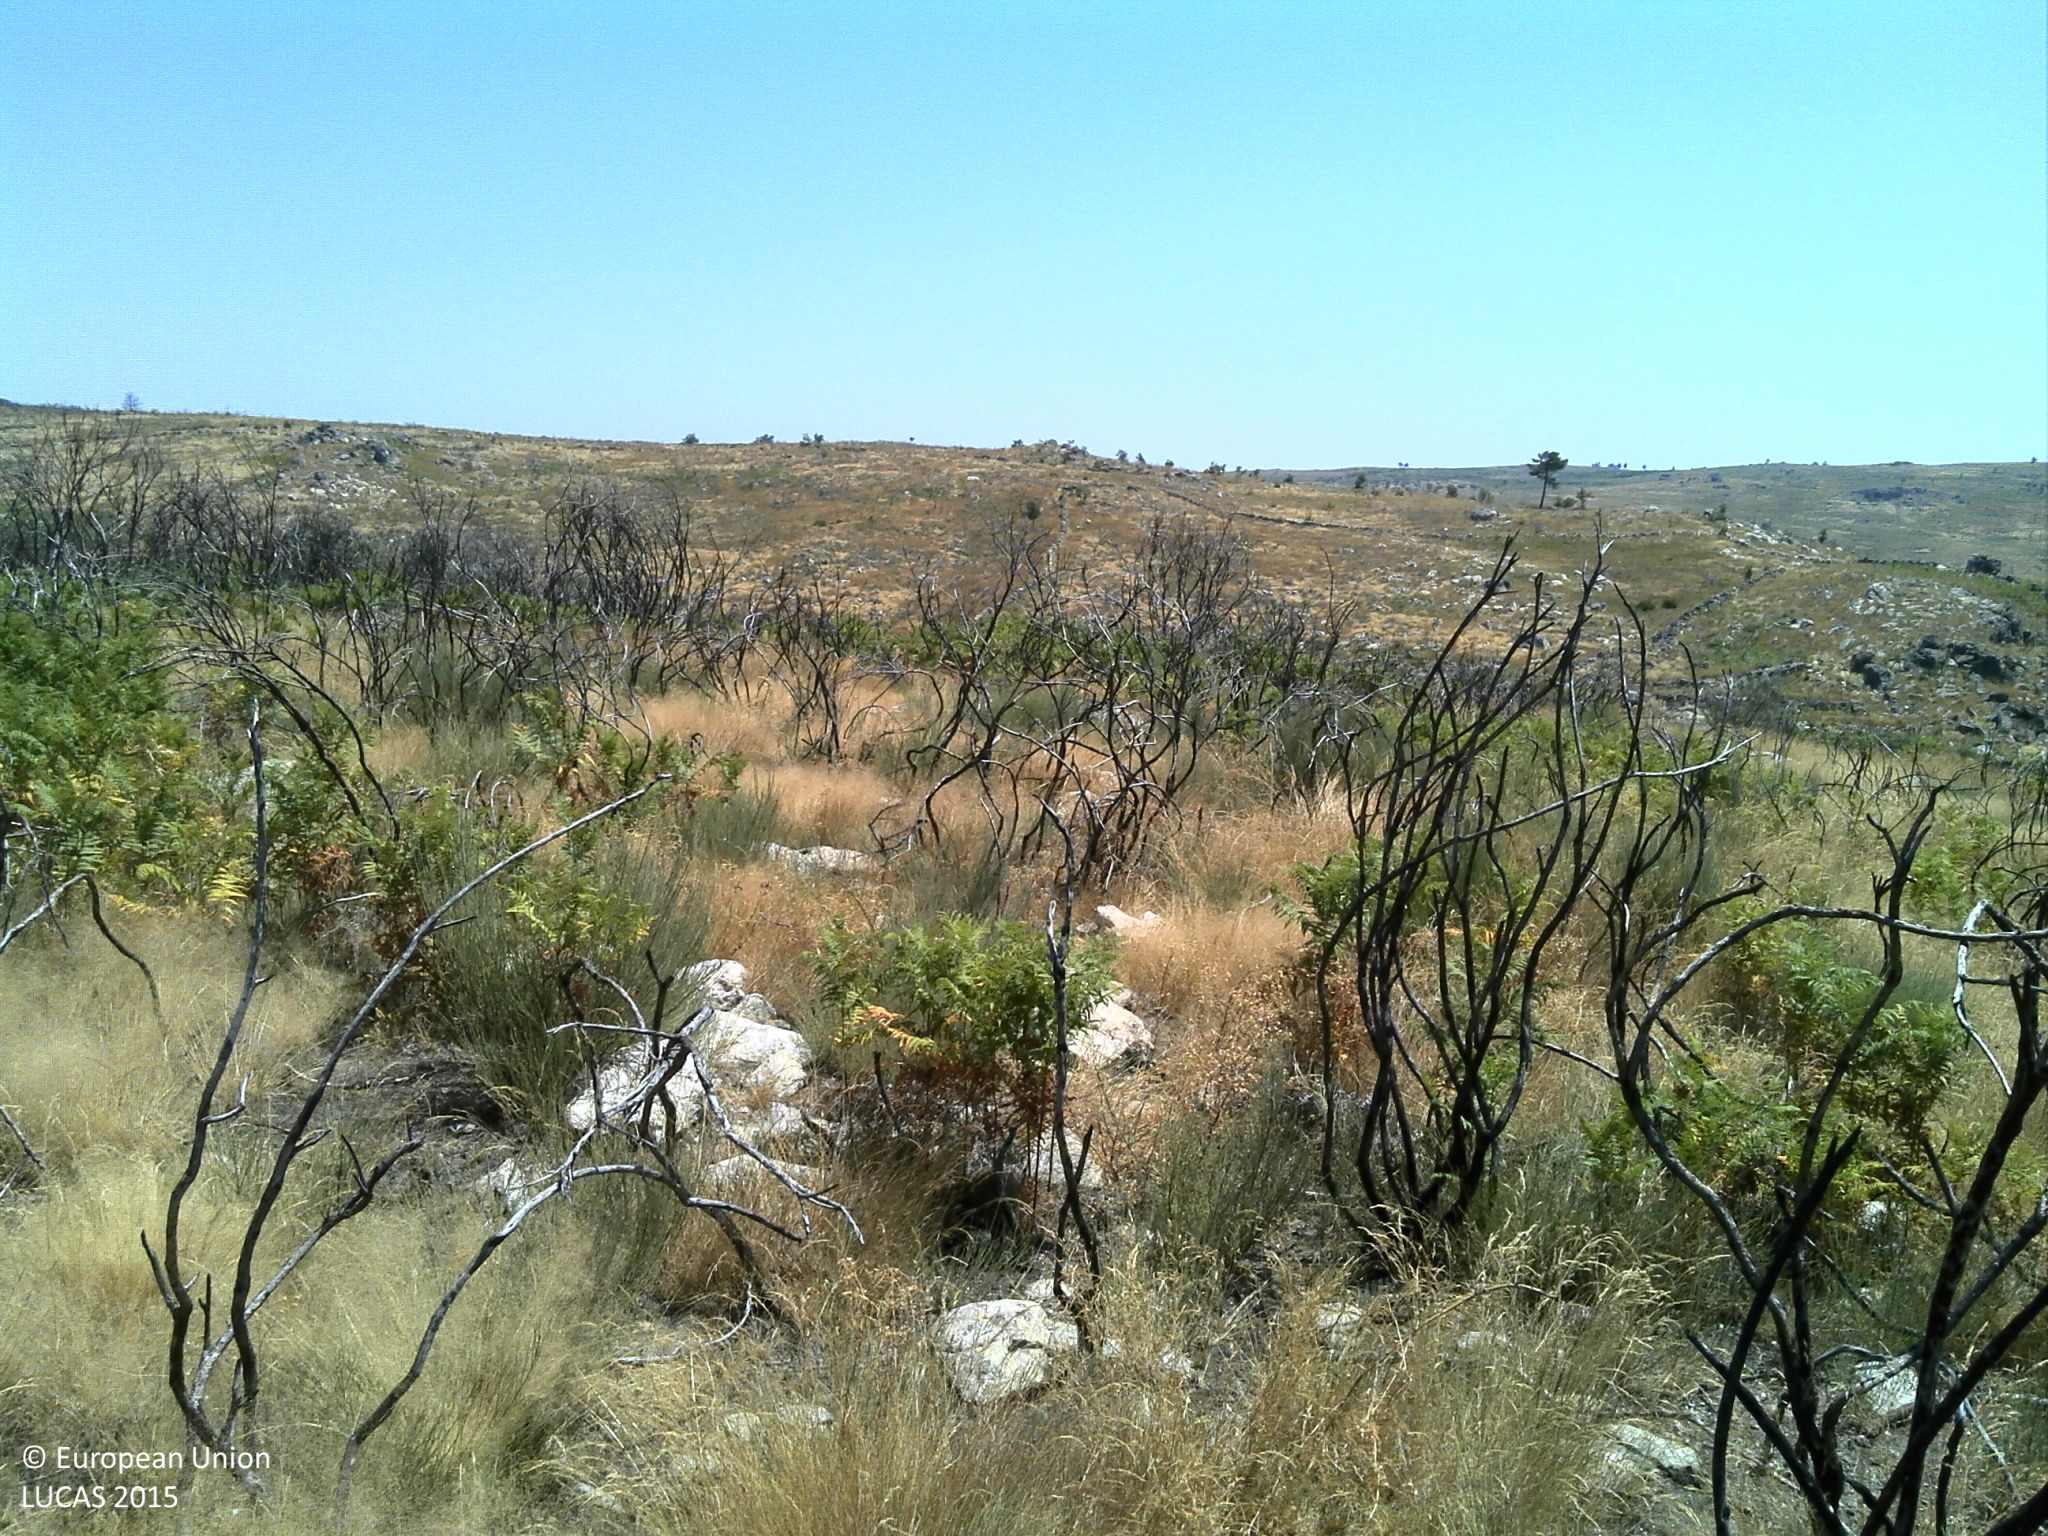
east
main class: Grassland
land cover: Grassland without tree/shrub cover
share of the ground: 50 - 75 %
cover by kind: herbaceous plants 60 %, consolidated bare surface 20 %, unconsolidated bare surface 15 %, shrubs 5 %
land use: Semi-natural and natural areas not in use
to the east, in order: Grassland without tree/shrub cover; Shrubland without tree cover; Rock outcrops; Grassland without tree/shrub cover; Tracks; Grassland without tree/shrub cover; Dry stone walls; Grassland without tree/shrub cover; Shrubland without tree cover; Dry stone walls; Shrubland without tree cover; Grassland without tree/shrub cover; Shrubland without tree cover; Dry stone walls; Shrubland without tree cover; Dry stone walls; Grassland without tree/shrub cover; Rock outcrops; Grassland without tree/shrub cover
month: July
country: PT
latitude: 40.8754
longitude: -7.4038
